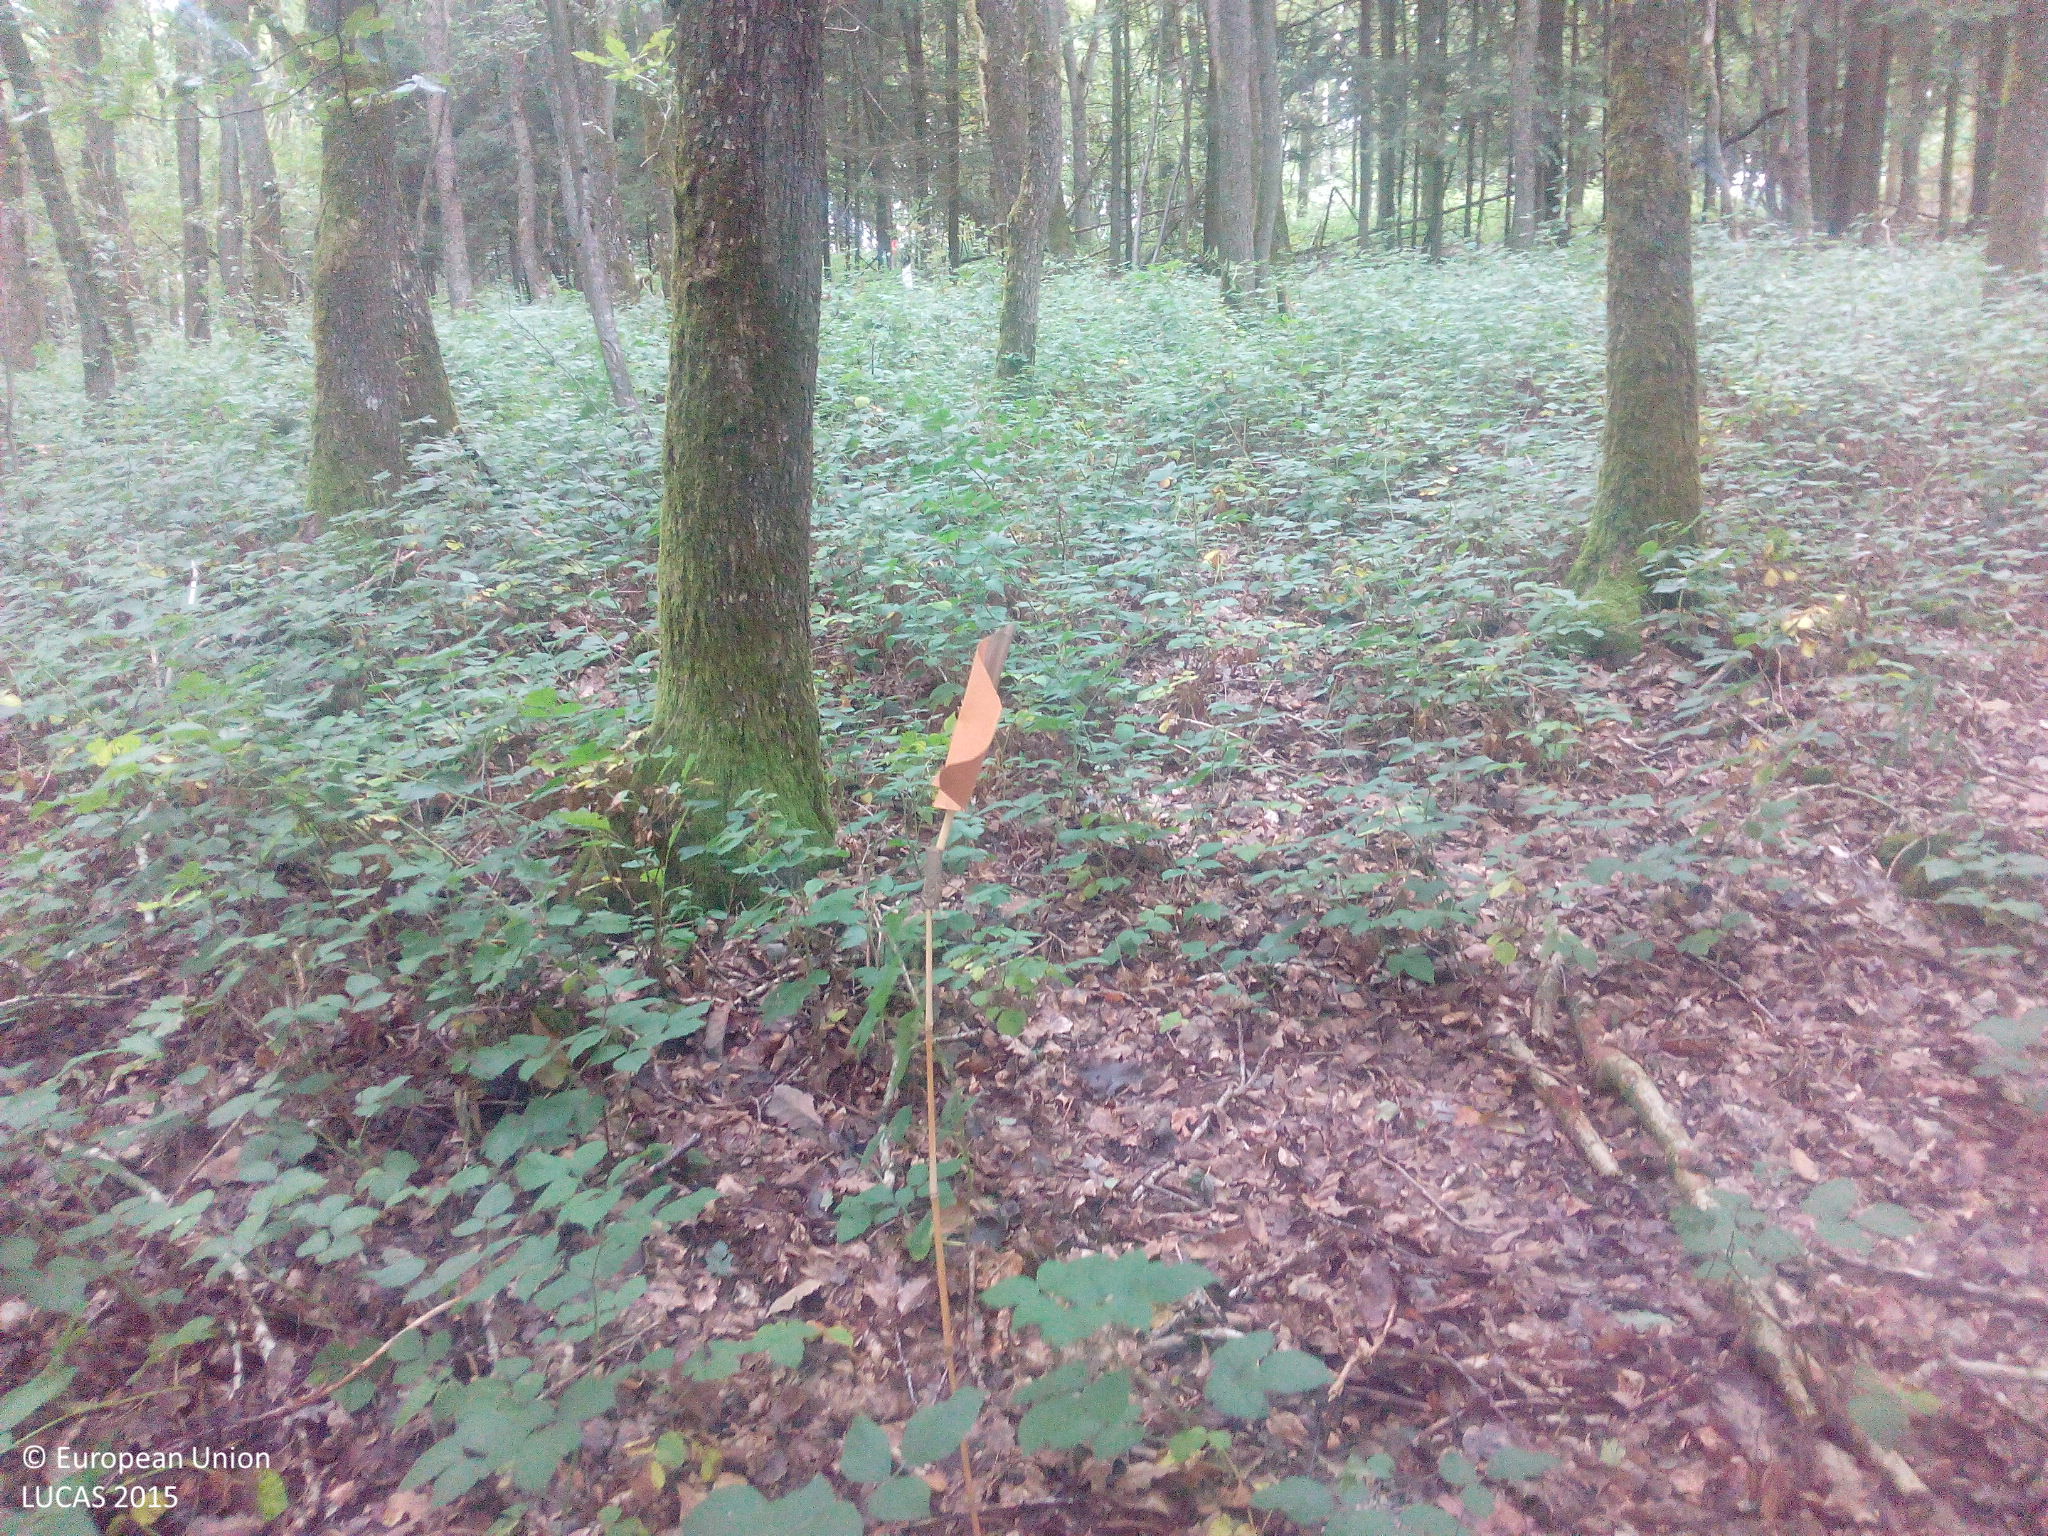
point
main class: Woodland
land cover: Broadleaved woodland
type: mesophytic deciduous forest
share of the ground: > 75 %
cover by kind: broadleaved forest trees 100 %
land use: Forestry
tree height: > 5 m
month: August
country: DE
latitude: 50.1779
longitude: 6.2886
